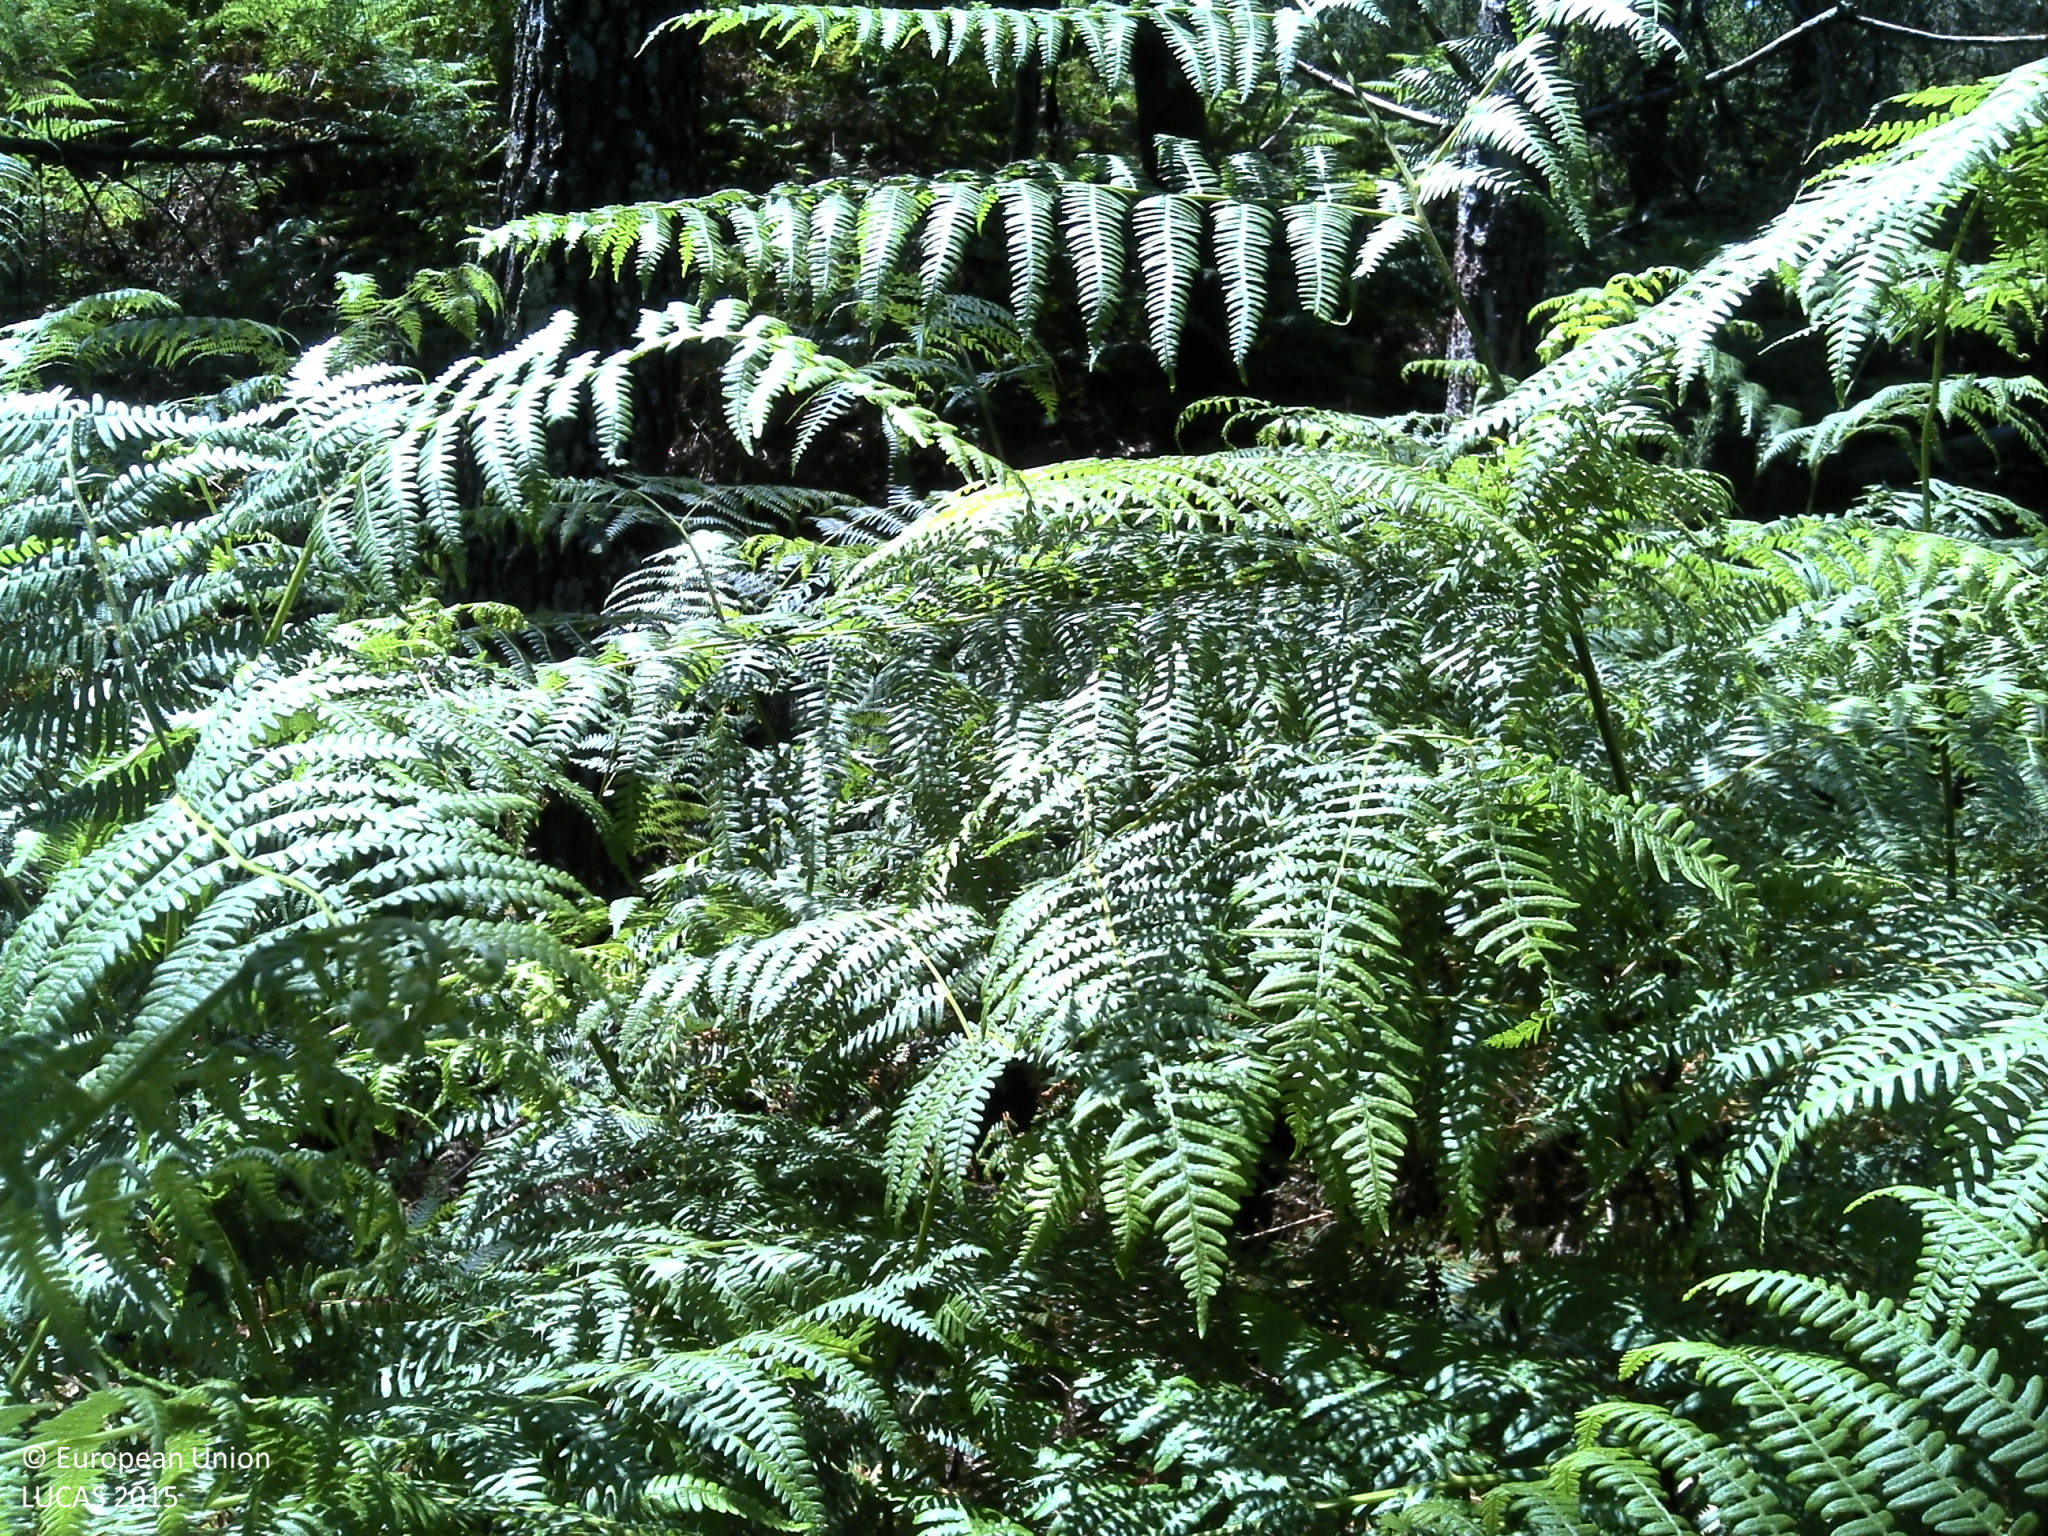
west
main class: Woodland
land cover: Pine dominated mixed woodland
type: coniferous forest of the mediterranean region
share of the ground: 50 - 75 %
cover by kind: coniferous forest trees 75 %, broadleaved forest trees 25 %
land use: Forestry
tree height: > 5 m
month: June
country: PT
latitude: 41.9380
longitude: -8.4578
